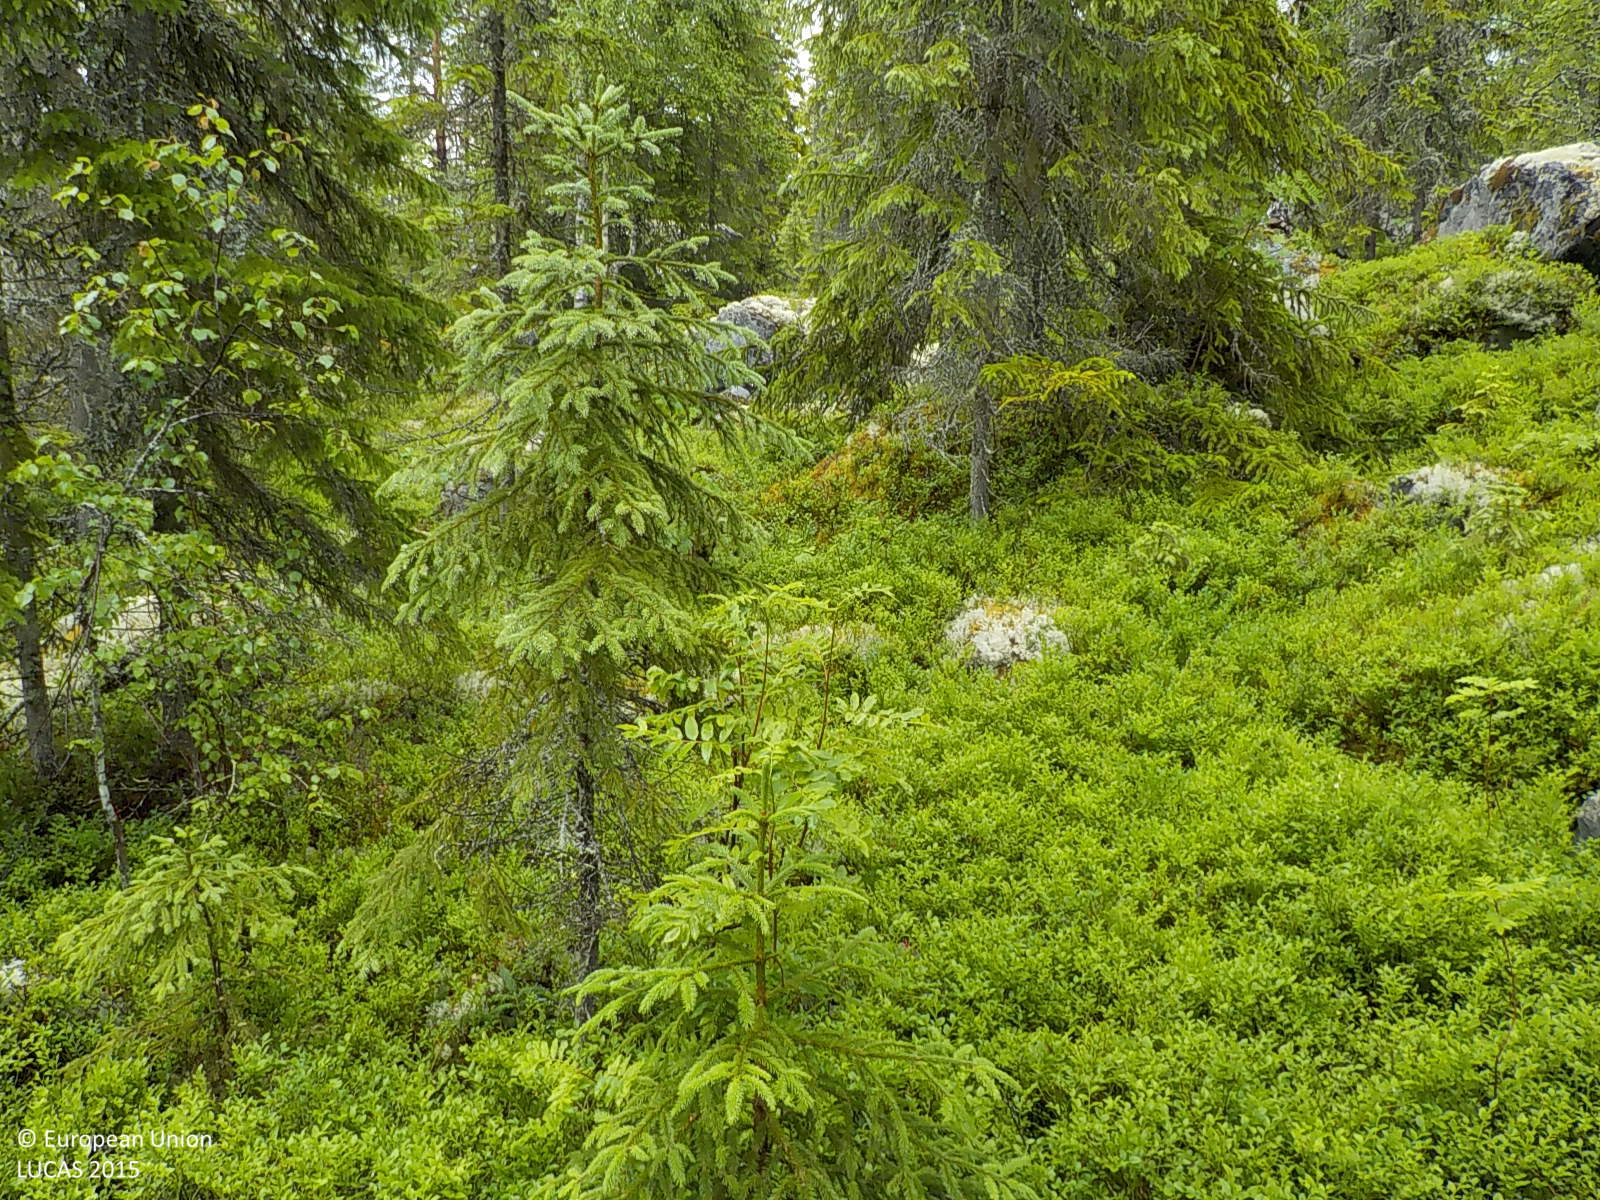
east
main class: Woodland
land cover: Spruce dominated mixed woodland
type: boreal forest
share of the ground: 50 - 75 %
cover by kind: coniferous forest trees 45 %, shrubs 30 %, broadleaved forest trees 15 %, lichens and mosses 10 %
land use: Forestry
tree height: > 5 m
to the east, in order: Spruce dominated mixed woodland; Shrubland without tree cover; Other coniferous woodland; Other mixed woodland
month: July
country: SE
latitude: 63.1584
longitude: 18.0567
